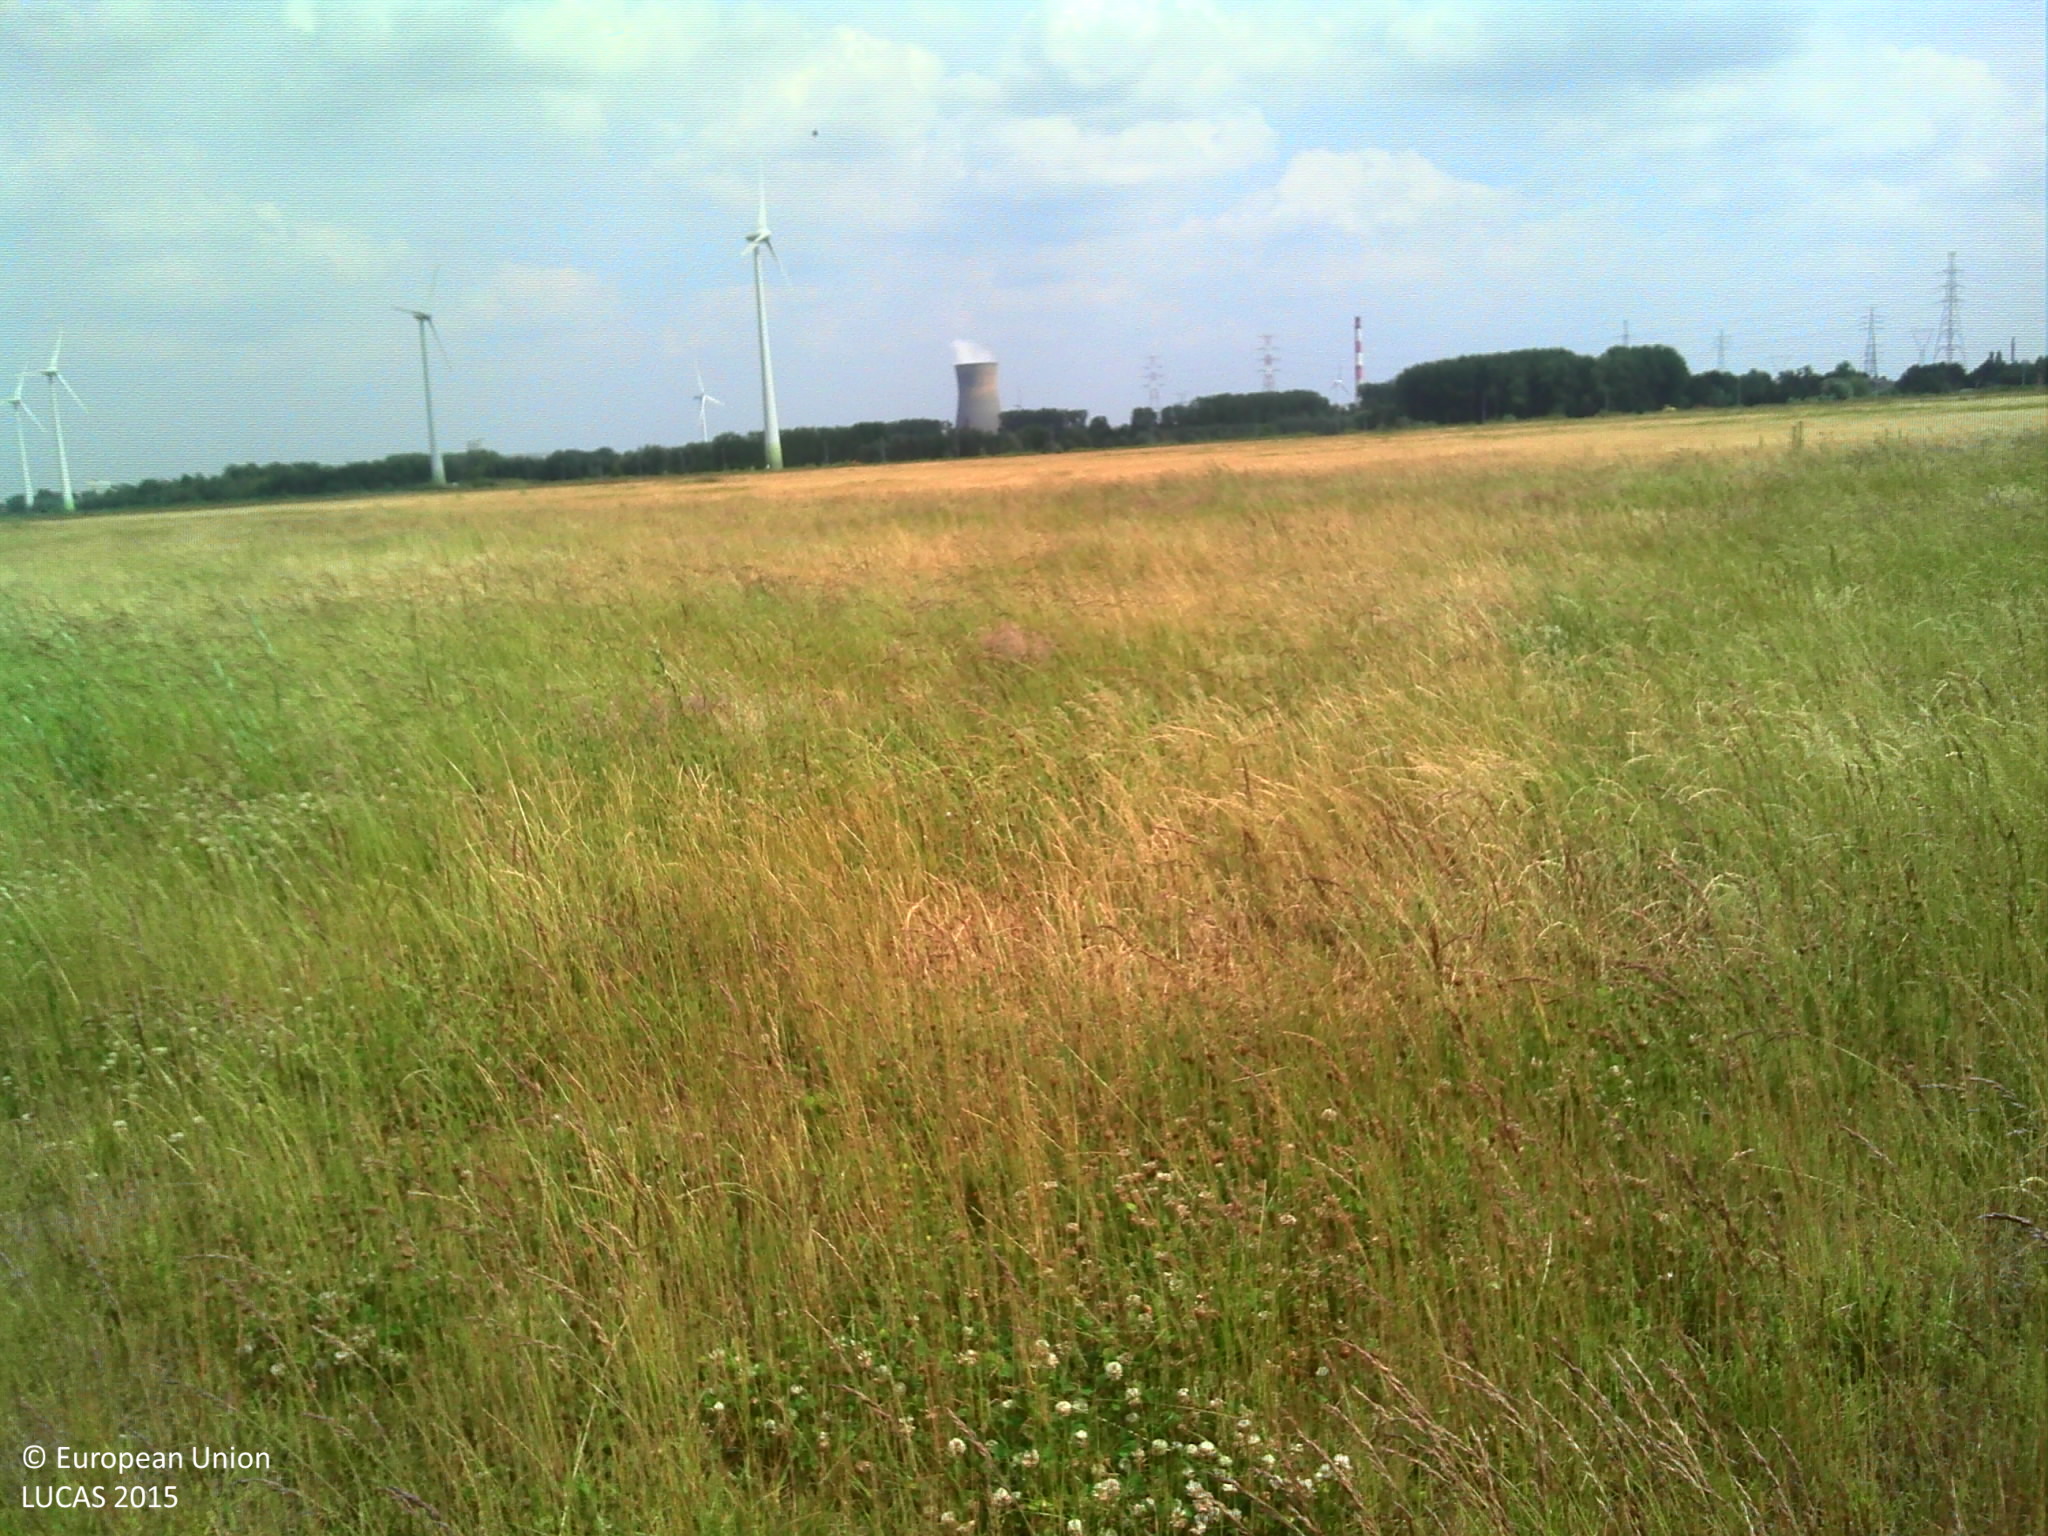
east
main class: Grassland
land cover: Grassland without tree/shrub cover
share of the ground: > 75 %
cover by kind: herbaceous plants 100 %
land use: Semi-natural and natural areas not in use
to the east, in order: Grassland without tree/shrub cover
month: June
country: BE
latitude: 51.1487
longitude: 3.7460
